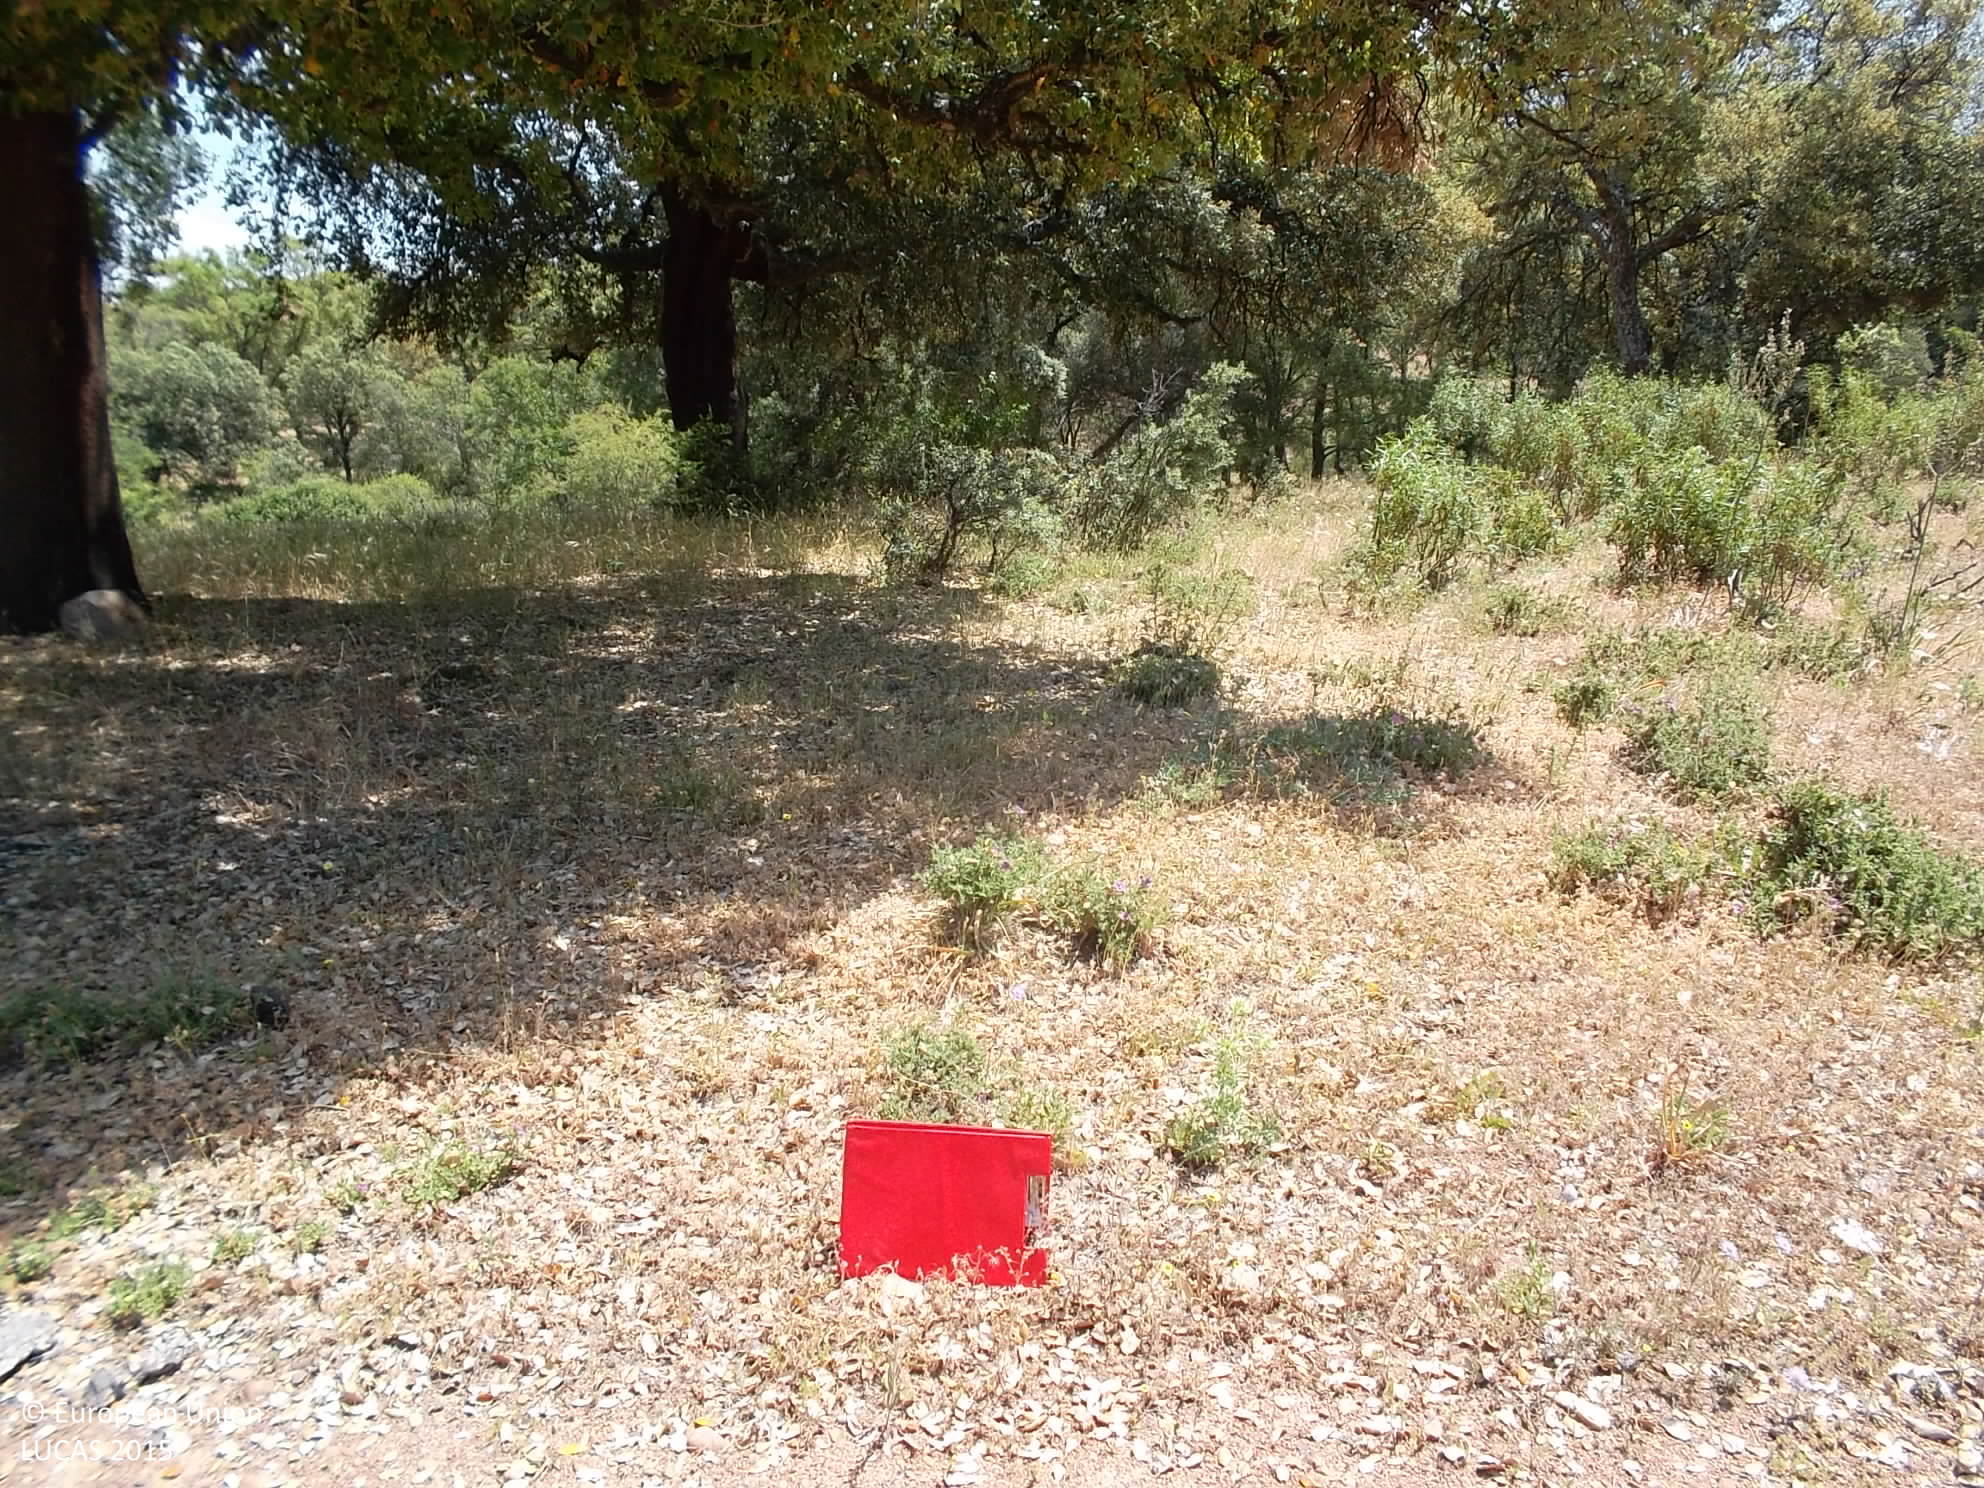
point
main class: Woodland
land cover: Broadleaved woodland
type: broadleaved evergreen forest
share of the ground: 25 - 50 %
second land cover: Spontaneously vegetated surfaces
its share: > 75 %
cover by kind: herbaceous plants 60 %, broadleaved forest trees 40 %
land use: Forestry
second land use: Agriculture (excluding fallow land and kitchen gardens)
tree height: > 5 m
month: May
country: ES
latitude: 38.5422
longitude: -4.3723
